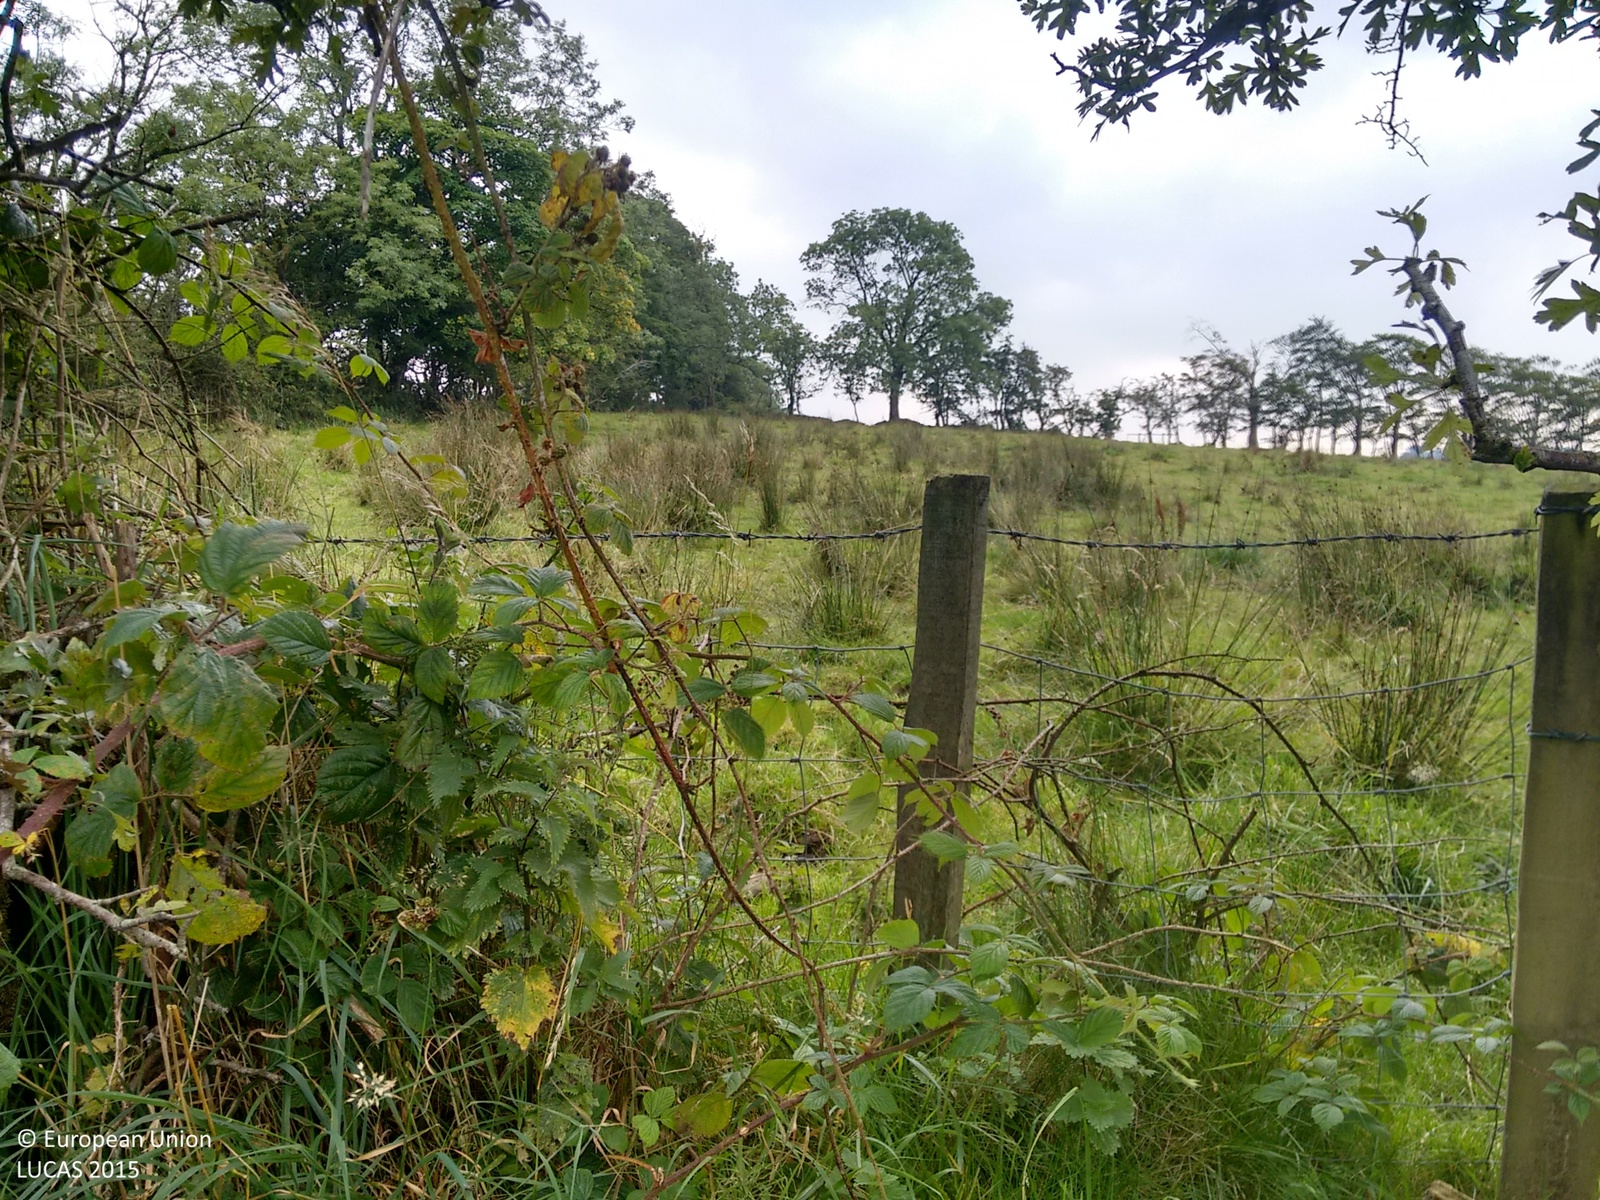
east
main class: Grassland
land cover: Grassland without tree/shrub cover
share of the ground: > 75 %
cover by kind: herbaceous plants 100 %
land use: Agriculture (excluding fallow land and kitchen gardens)
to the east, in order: Grassland without tree/shrub cover; Fences; Single bushes/trees; Grassland without tree/shrub cover; Abandoned hedges; Grassland without tree/shrub cover; Abandoned hedges; Fences; Grassland without tree/shrub cover; Managed hedges; Fences; Grassland without tree/shrub cover; Managed hedges; Grassland without tree/shrub cover
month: September
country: GB
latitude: 54.7859
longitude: -6.0174
